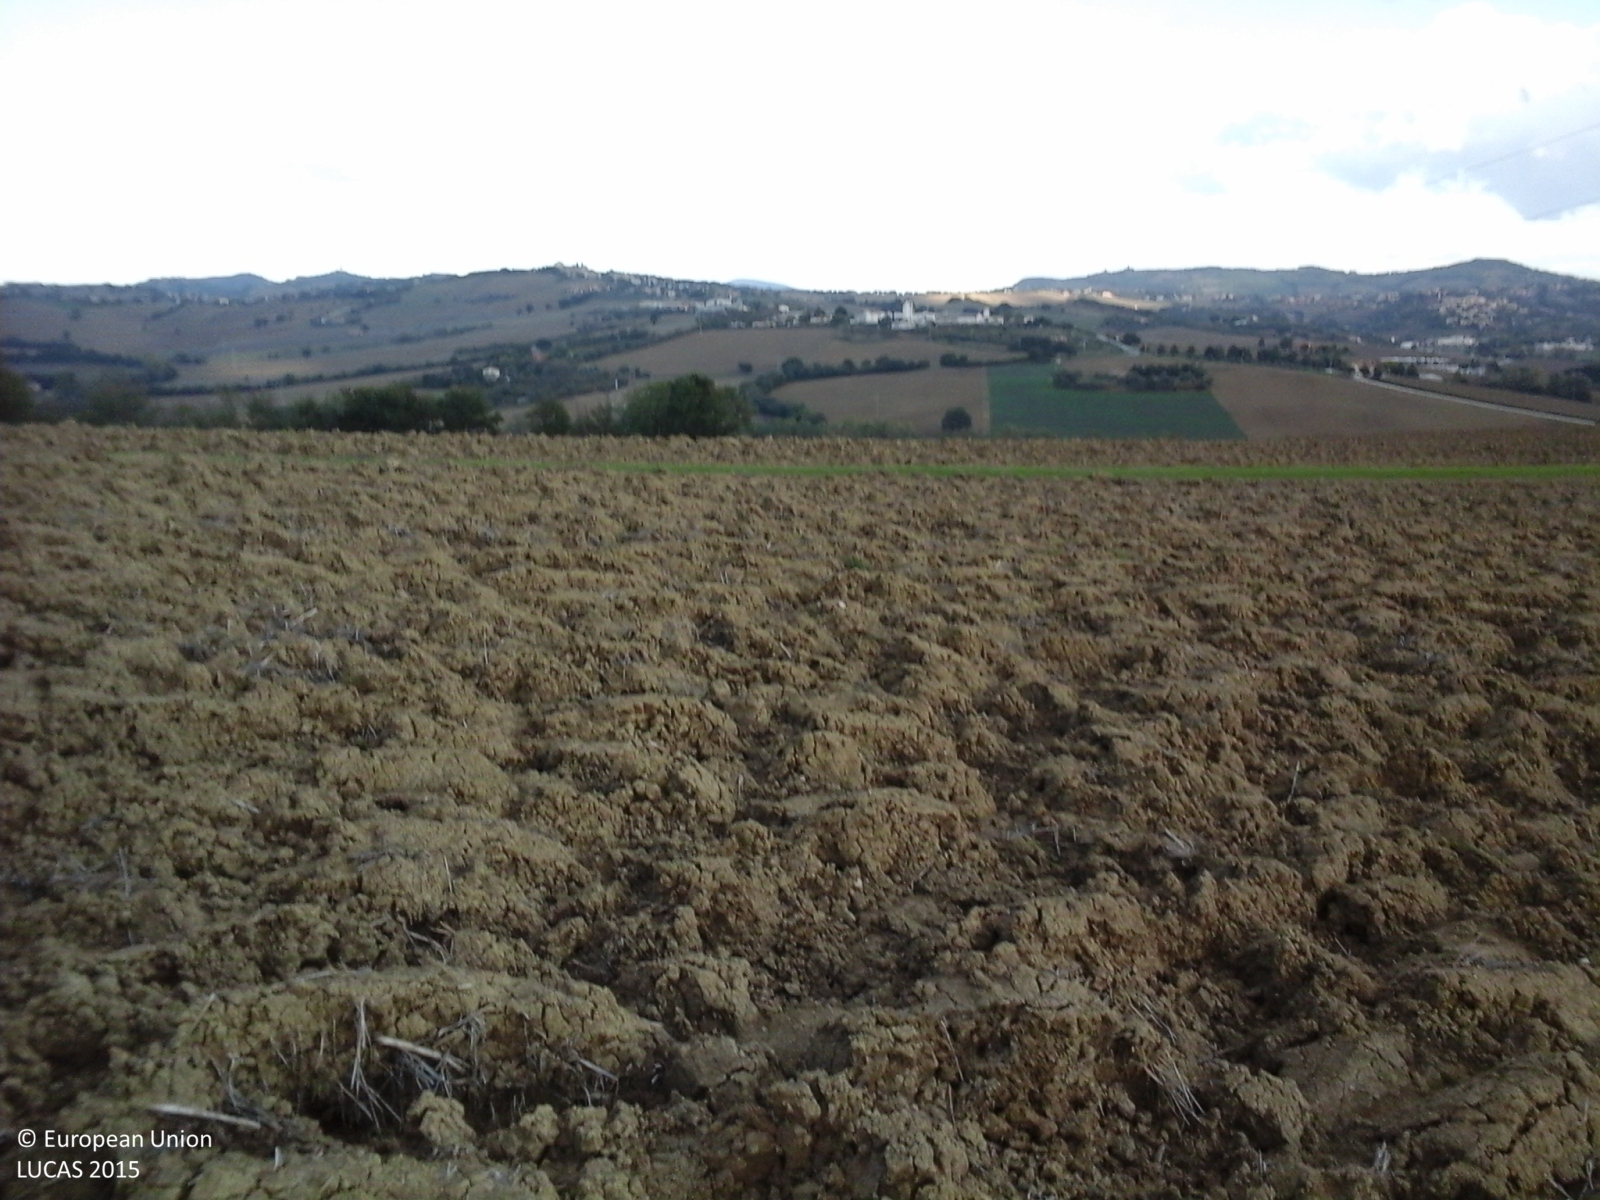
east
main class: Cropland
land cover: Durum wheat
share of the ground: < 10 %
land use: Agriculture (excluding fallow land and kitchen gardens)
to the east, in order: Durum wheat; Tracks; Durum wheat; Electric lines; Durum wheat
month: October
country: IT
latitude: 43.5383
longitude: 13.3456
